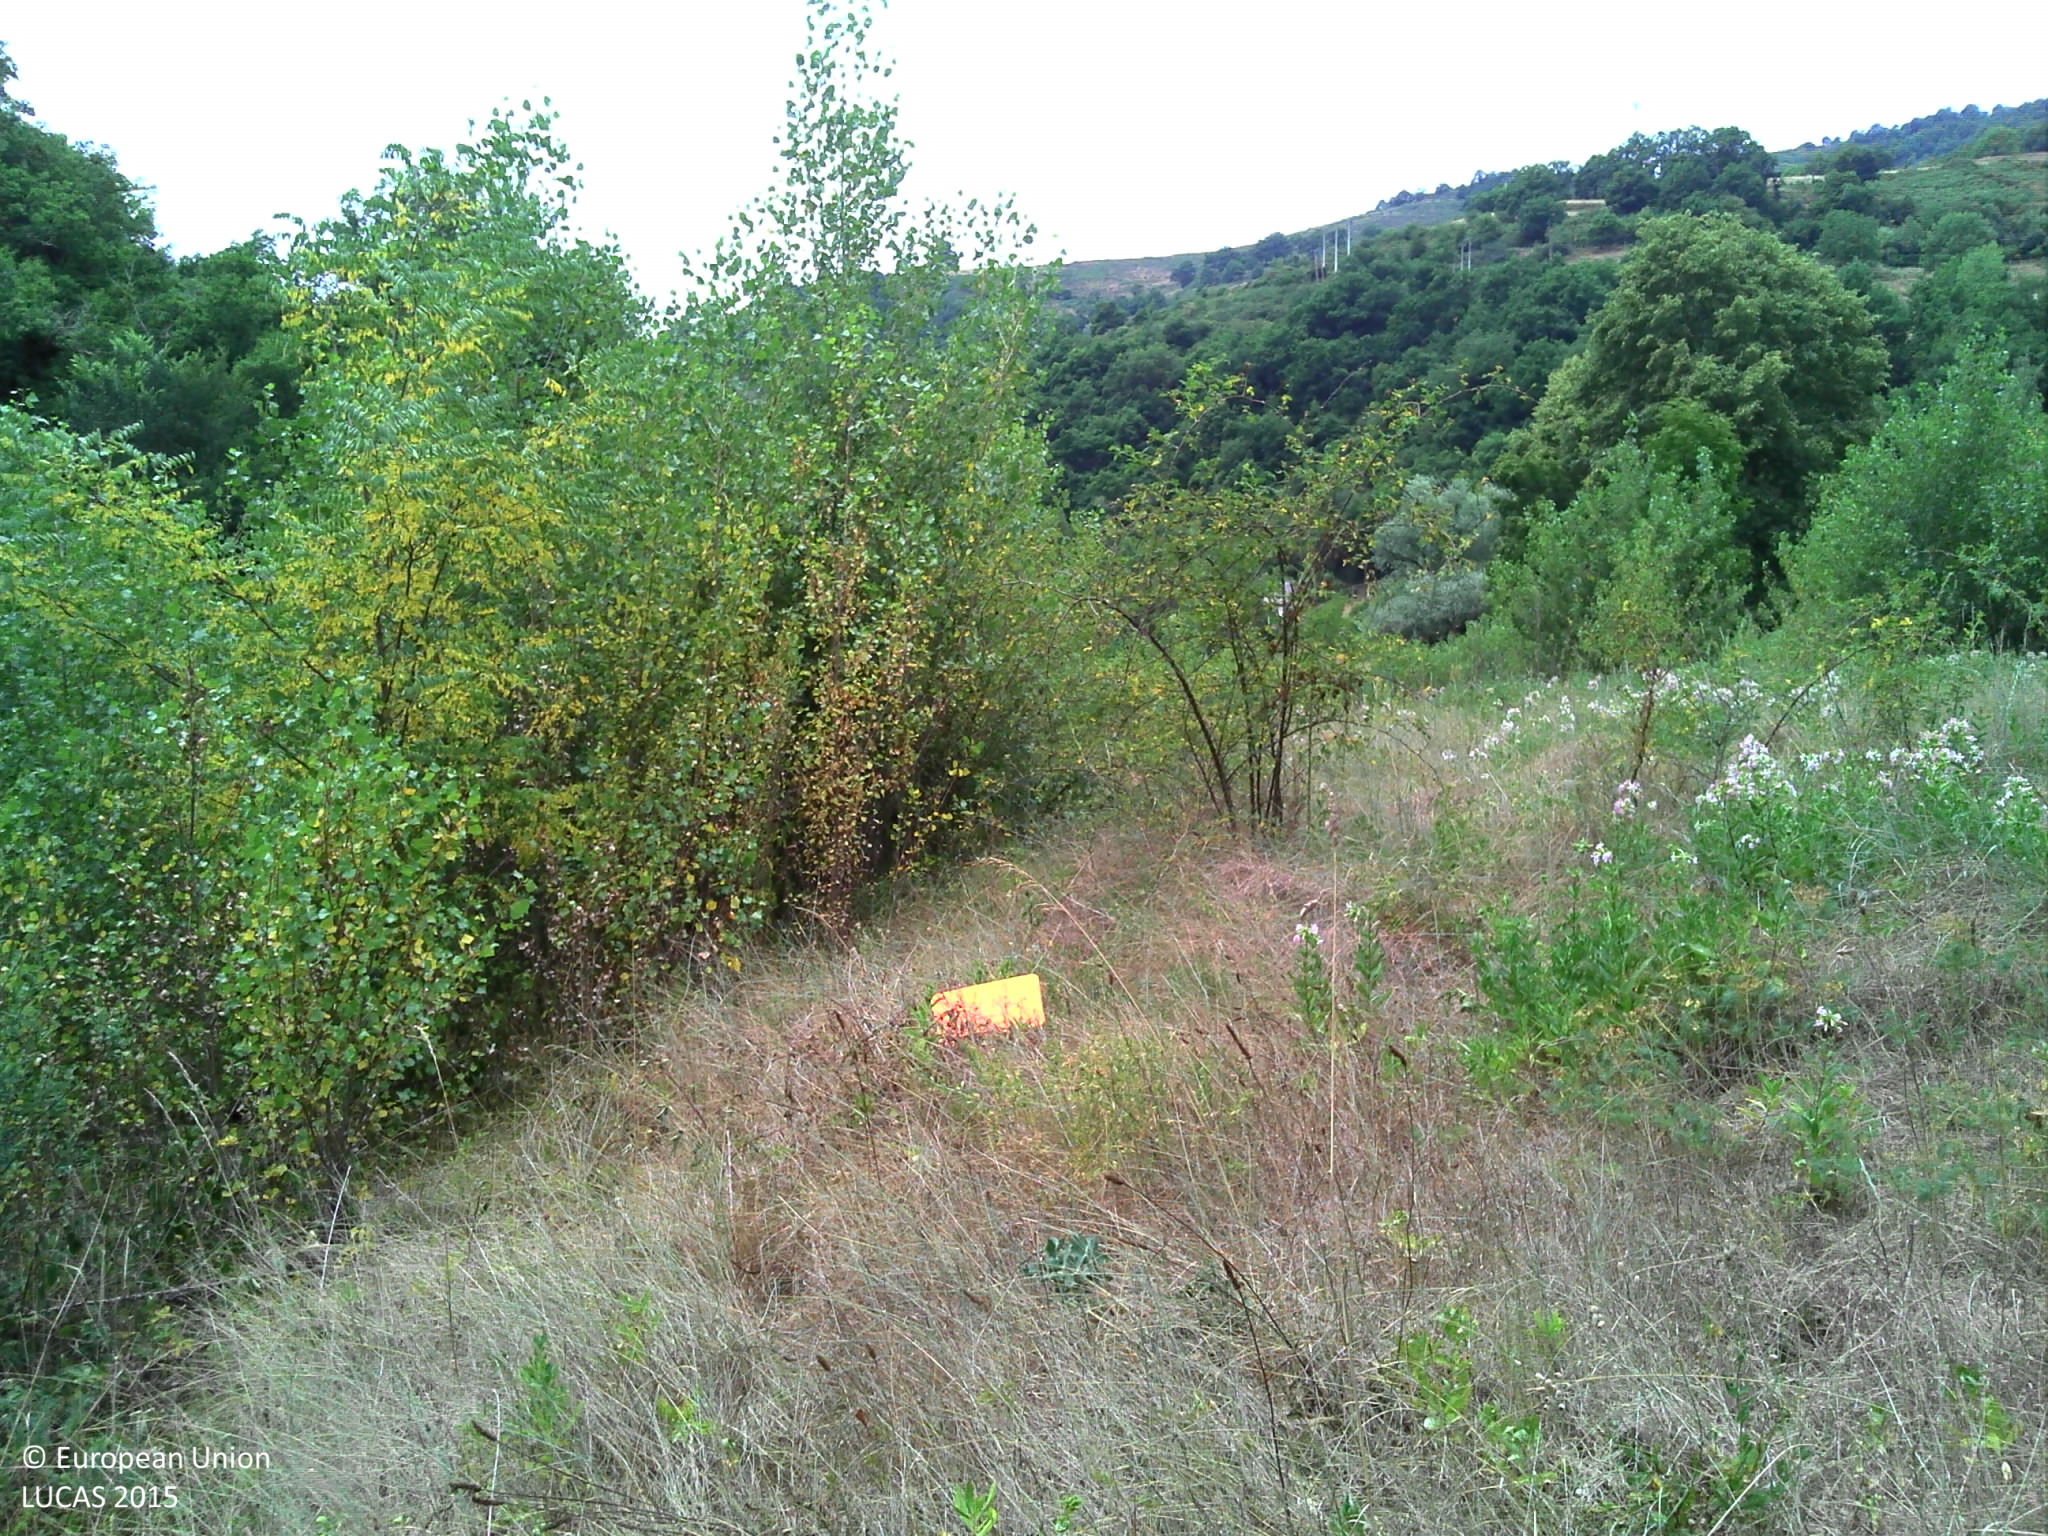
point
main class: Shrubland
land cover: Shrubland with sparse tree cover
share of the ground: > 75 %
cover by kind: shrubs 60 %, herbaceous plants 35 %, broadleaved forest trees 5 %
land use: Agriculture (excluding fallow land and kitchen gardens)
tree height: > 5 m
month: July
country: FR
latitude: 44.6438
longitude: 2.5507
